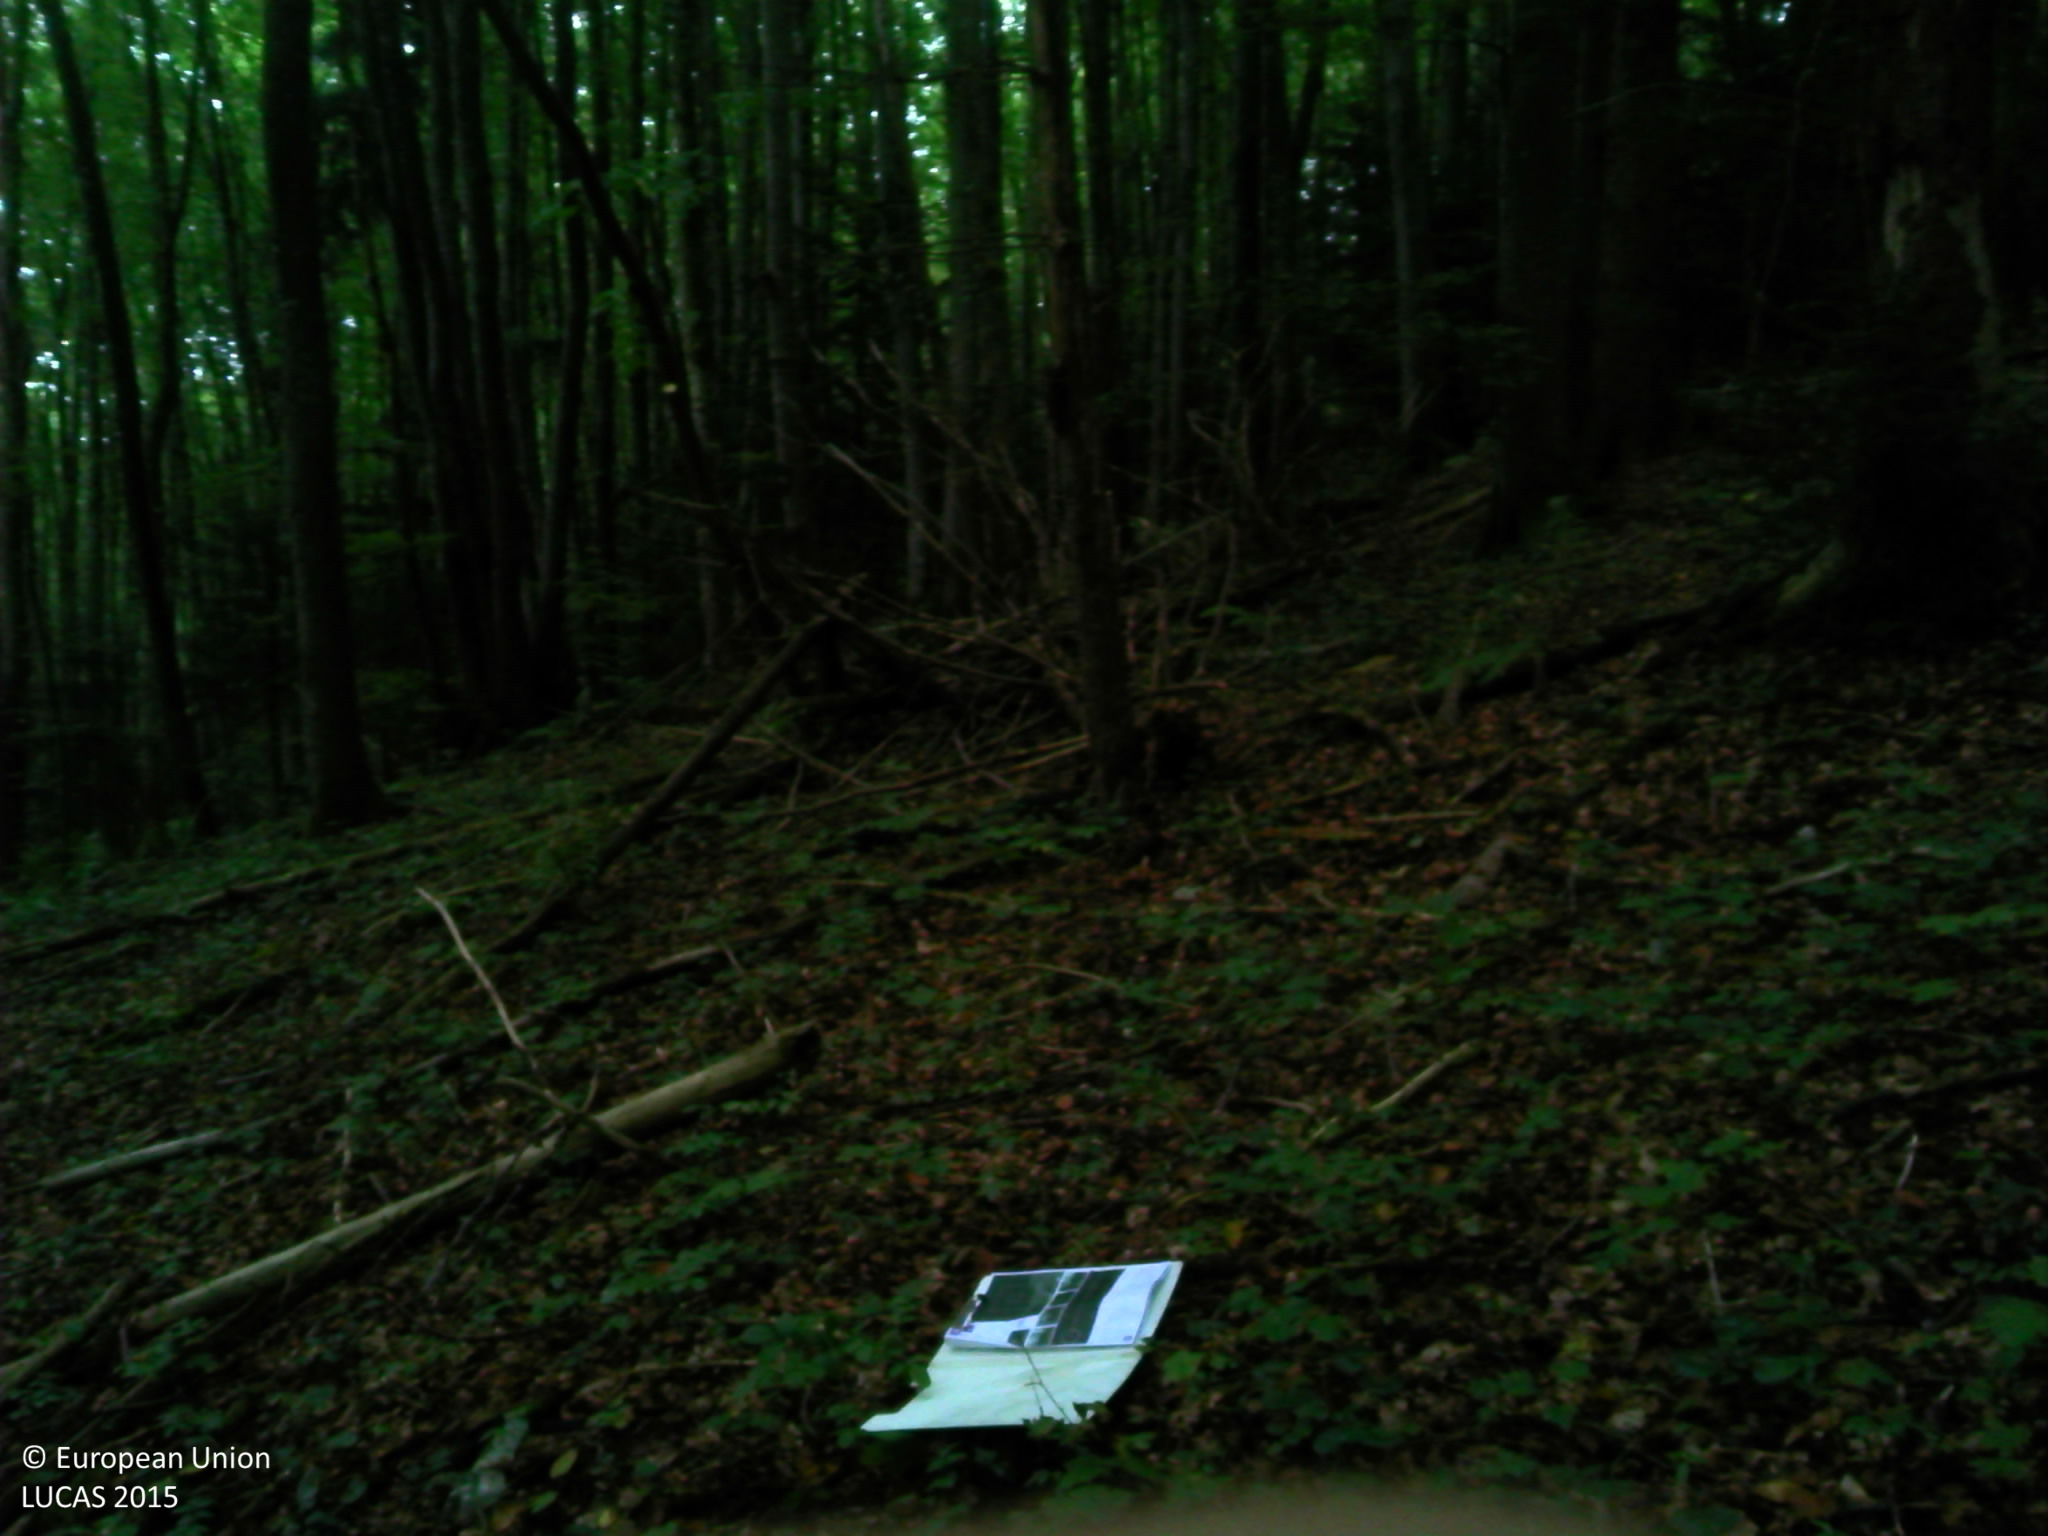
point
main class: Woodland
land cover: Spruce dominated mixed woodland
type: hemiboreal forest and nemoral coniferous forest and mixed broadleaved-coniferous forest
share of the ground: > 75 %
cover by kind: coniferous forest trees 60 %, broadleaved forest trees 40 %
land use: Forestry
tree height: > 5 m
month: September
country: FR
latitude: 47.3613
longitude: 6.6255
